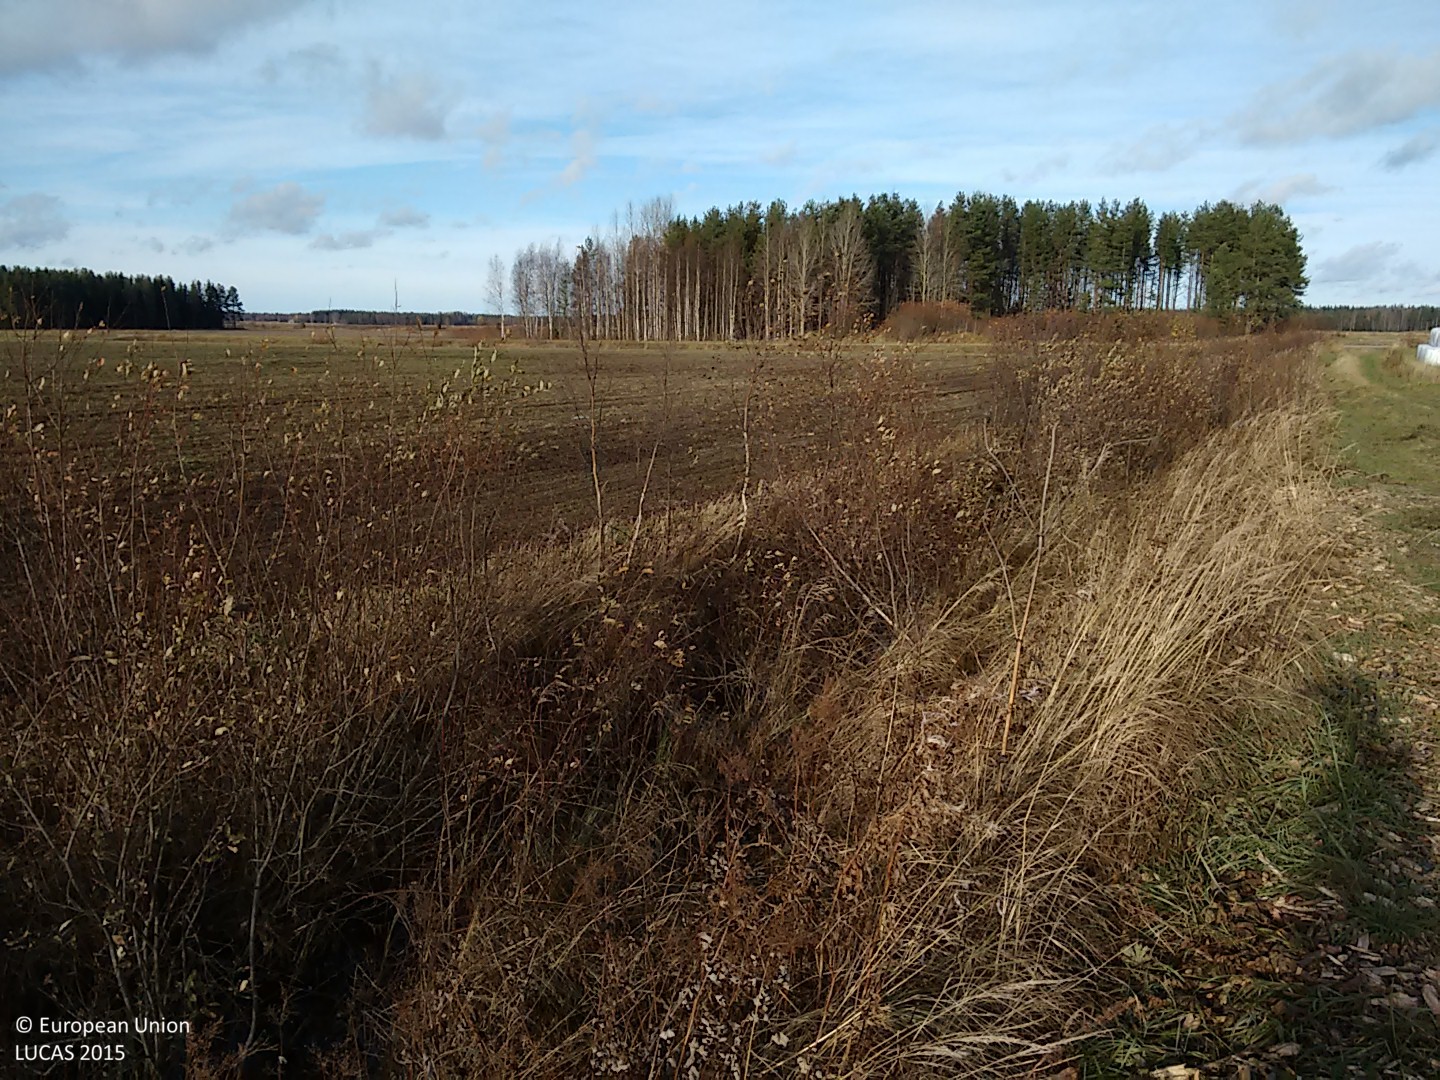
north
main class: Cropland
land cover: Oats
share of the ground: > 75 %
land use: Agriculture (excluding fallow land and kitchen gardens)
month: October
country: FI
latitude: 63.9537
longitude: 25.2153
